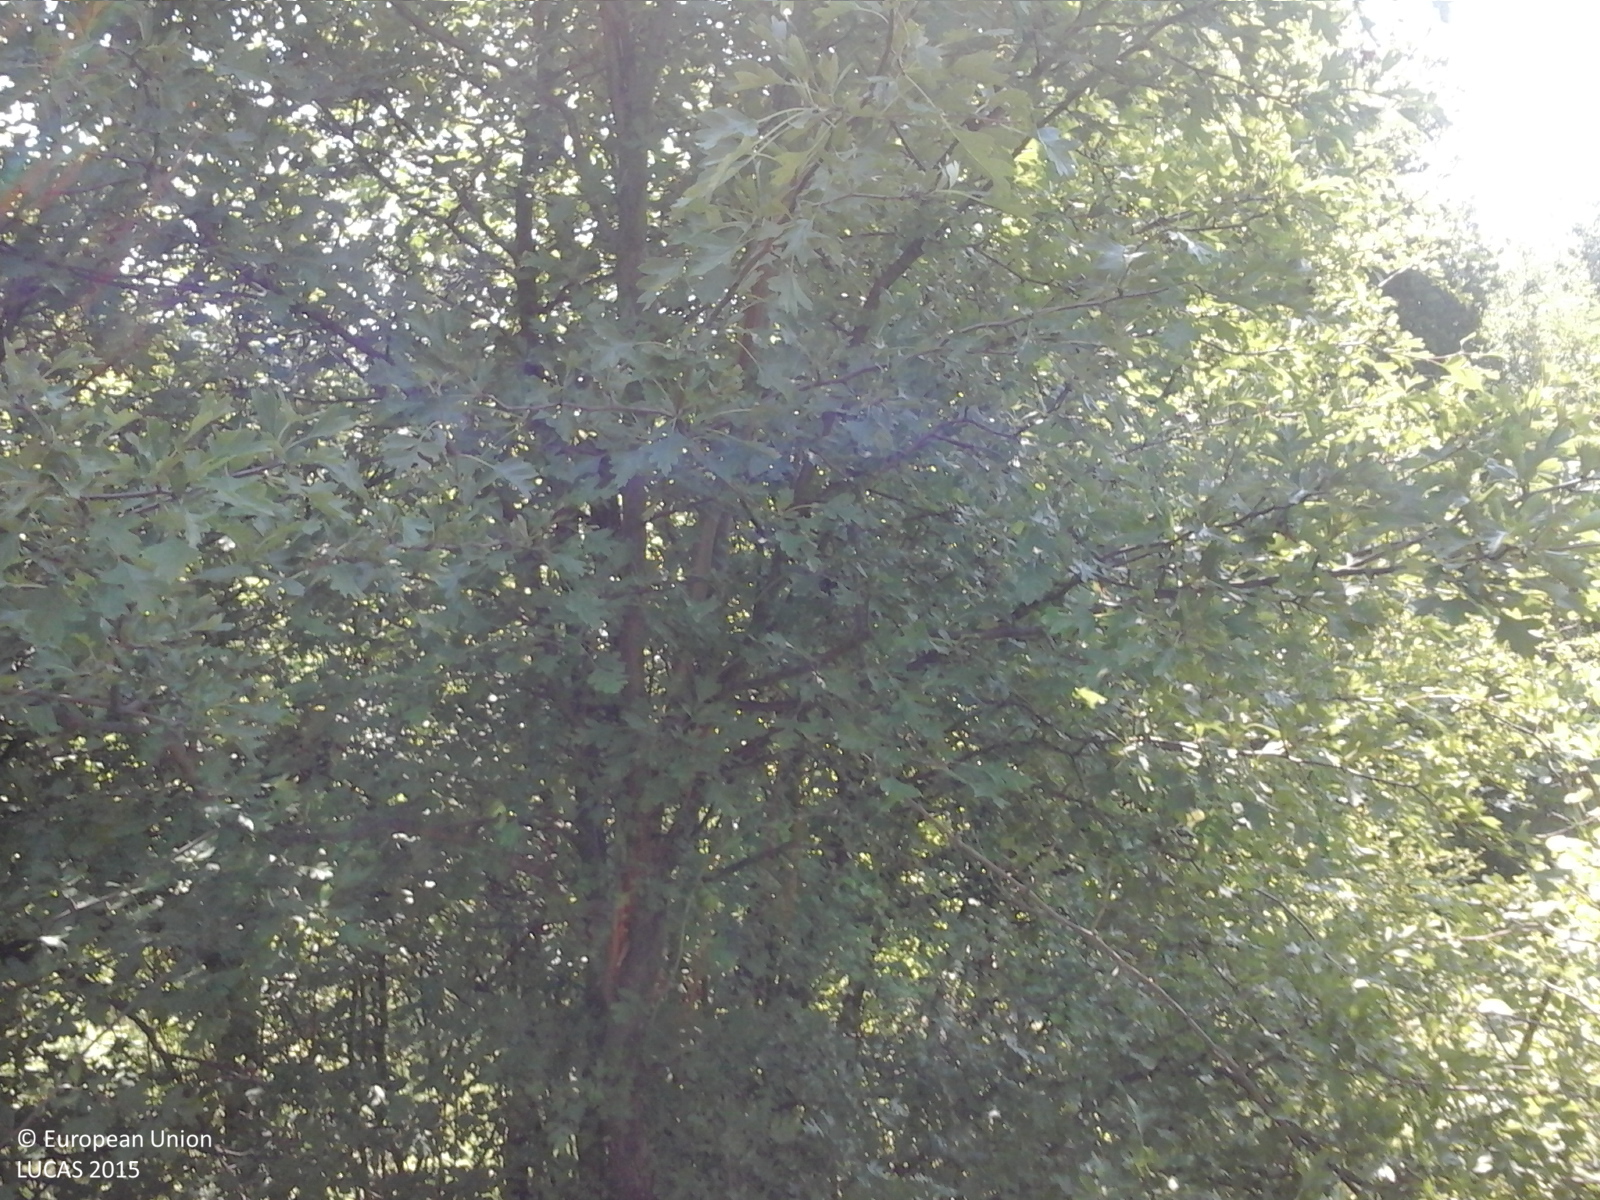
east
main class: Woodland
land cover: Broadleaved woodland
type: acidophilous oak and oak-birch forest
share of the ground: > 75 %
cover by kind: broadleaved forest trees 100 %
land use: Forestry
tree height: > 5 m
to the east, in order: Broadleaved woodland; Grassland with sparse tree/shrub cover; Tracks; Grassland with sparse tree/shrub cover
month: July
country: RO
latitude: 44.7975
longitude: 24.5748
